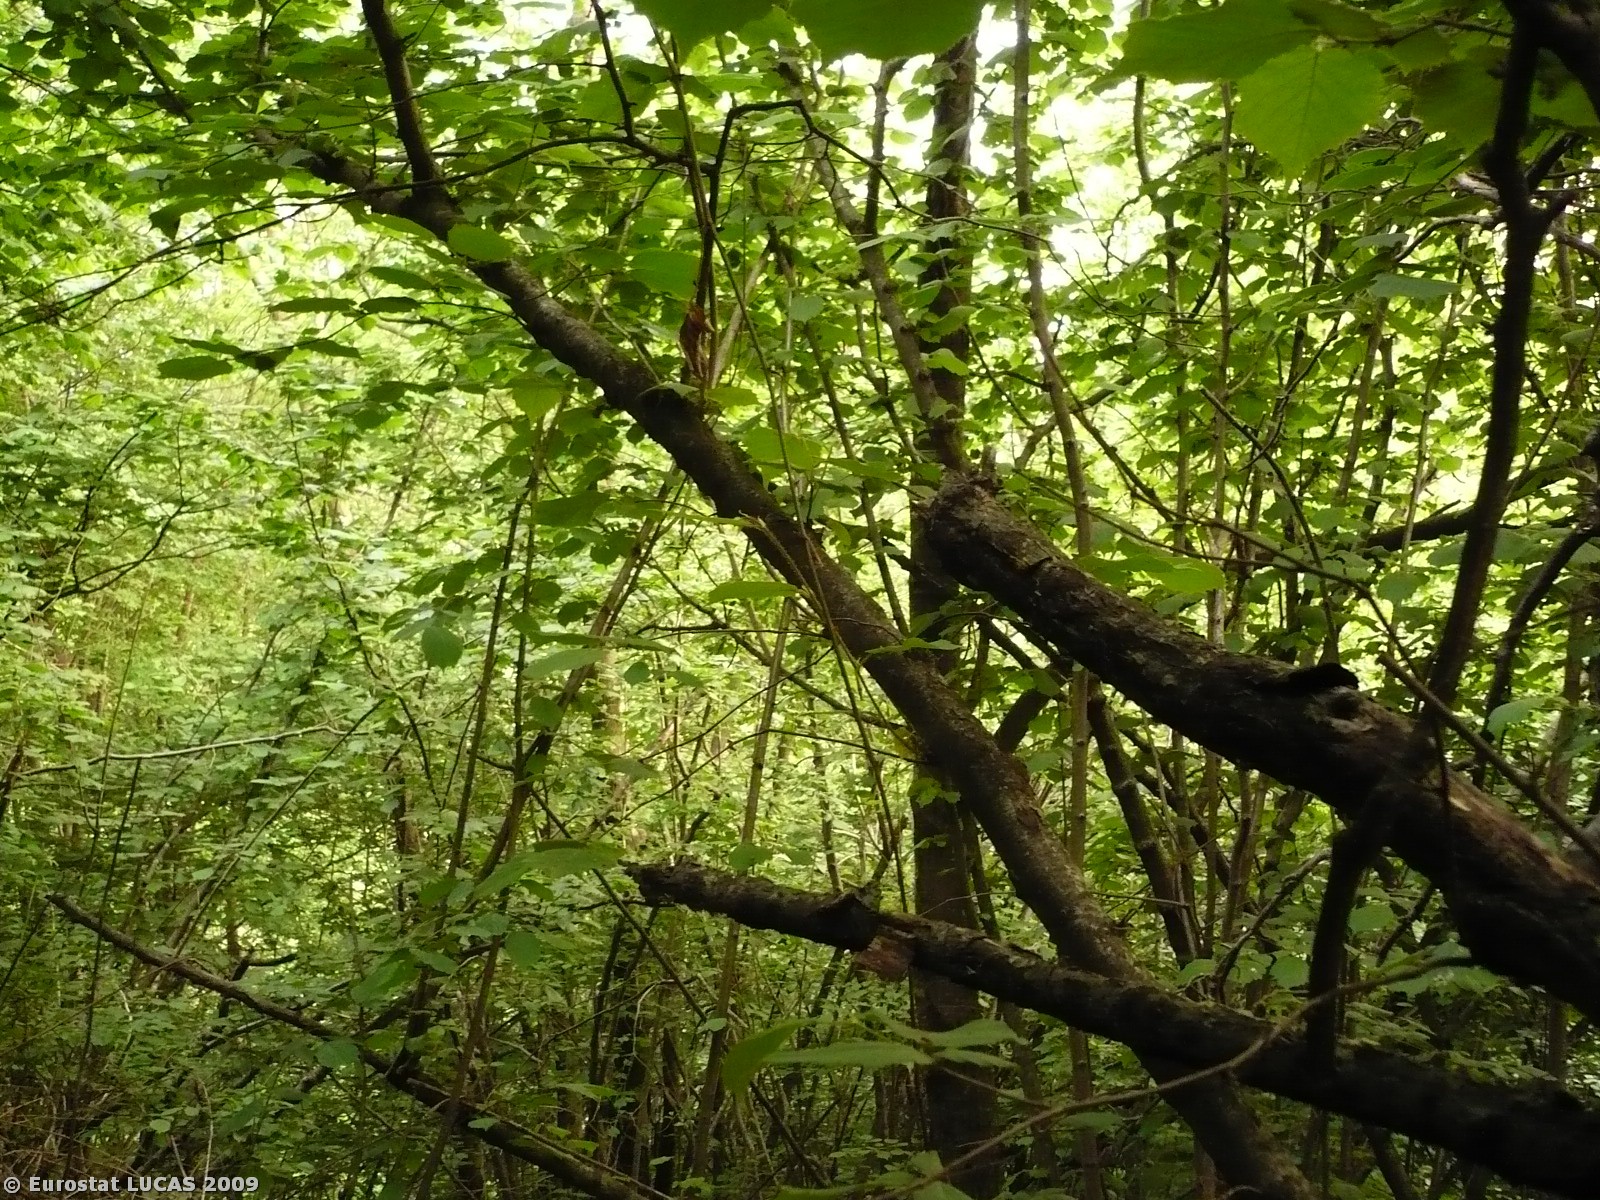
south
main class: Woodland
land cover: Broadleaved woodland
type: thermophilous deciduous forest
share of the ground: > 75 %
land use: Agriculture (excluding fallow land and kitchen gardens)
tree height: > 5 m
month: May
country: SI
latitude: 46.0535
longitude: 13.6799
